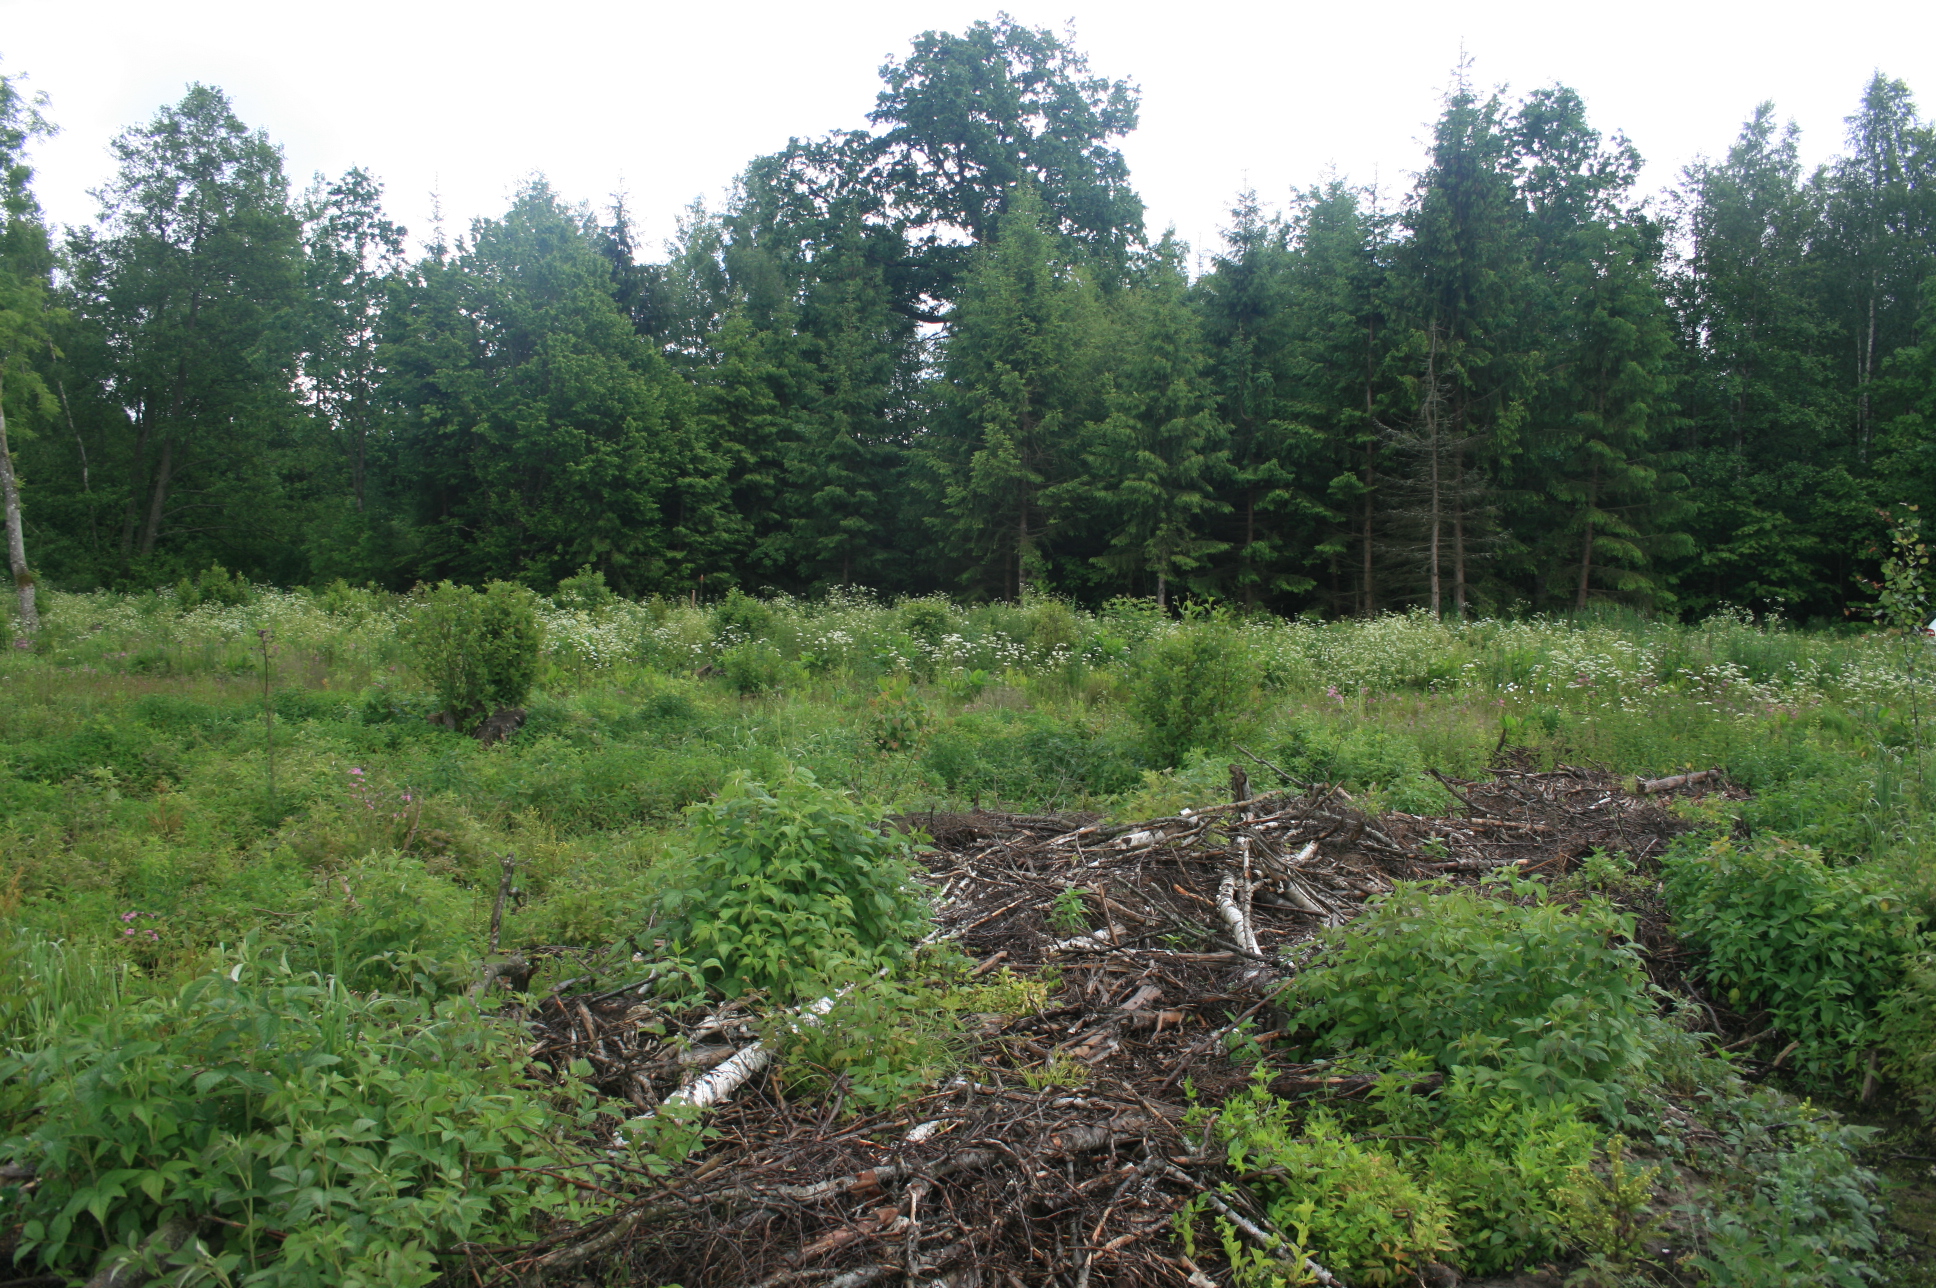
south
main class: Shrubland
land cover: Shrubland with sparse tree cover
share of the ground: > 75 %
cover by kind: shrubs 65 %, herbaceous plants 30 %, broadleaved forest trees 5 %
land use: Forestry
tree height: < 5 m
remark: Clear cut
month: June
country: LT
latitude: 55.3440
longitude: 22.0541
